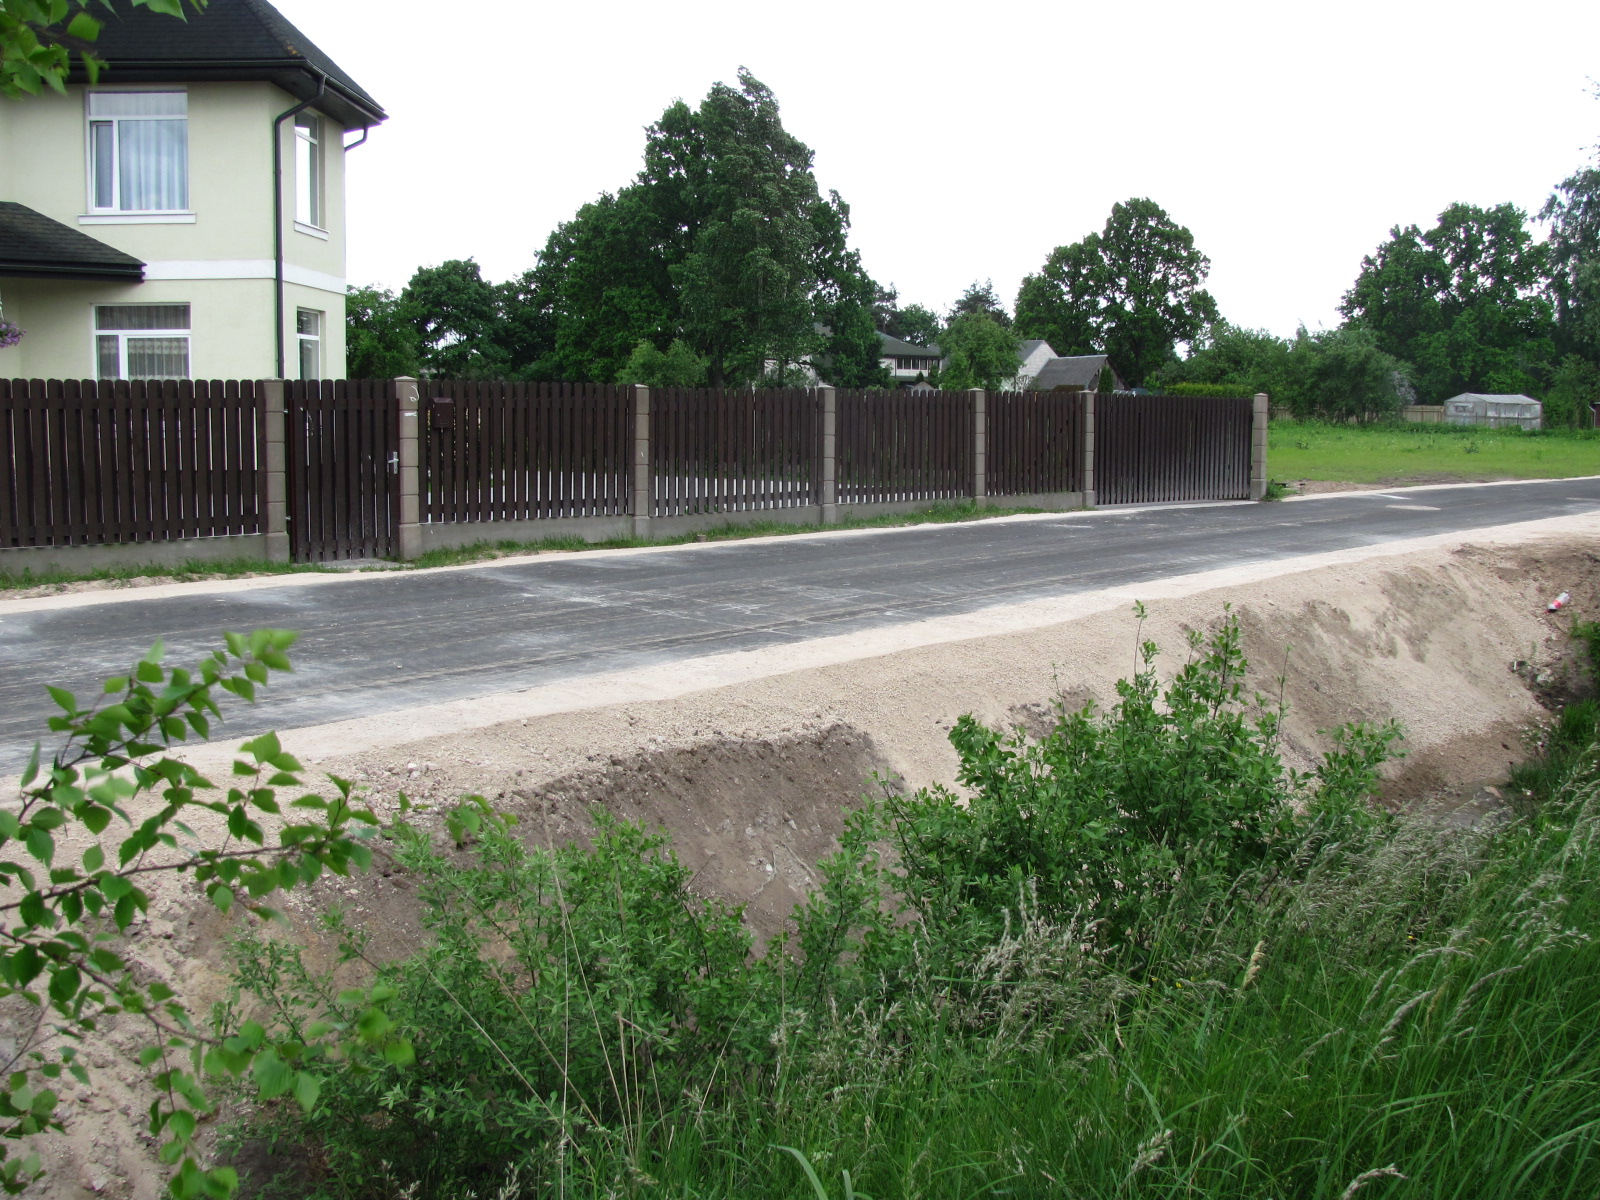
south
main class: Grassland
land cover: Grassland without tree/shrub cover
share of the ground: > 75 %
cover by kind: herbaceous plants 100 %
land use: Residential
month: June
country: LV
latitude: 56.8060
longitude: 23.9880
